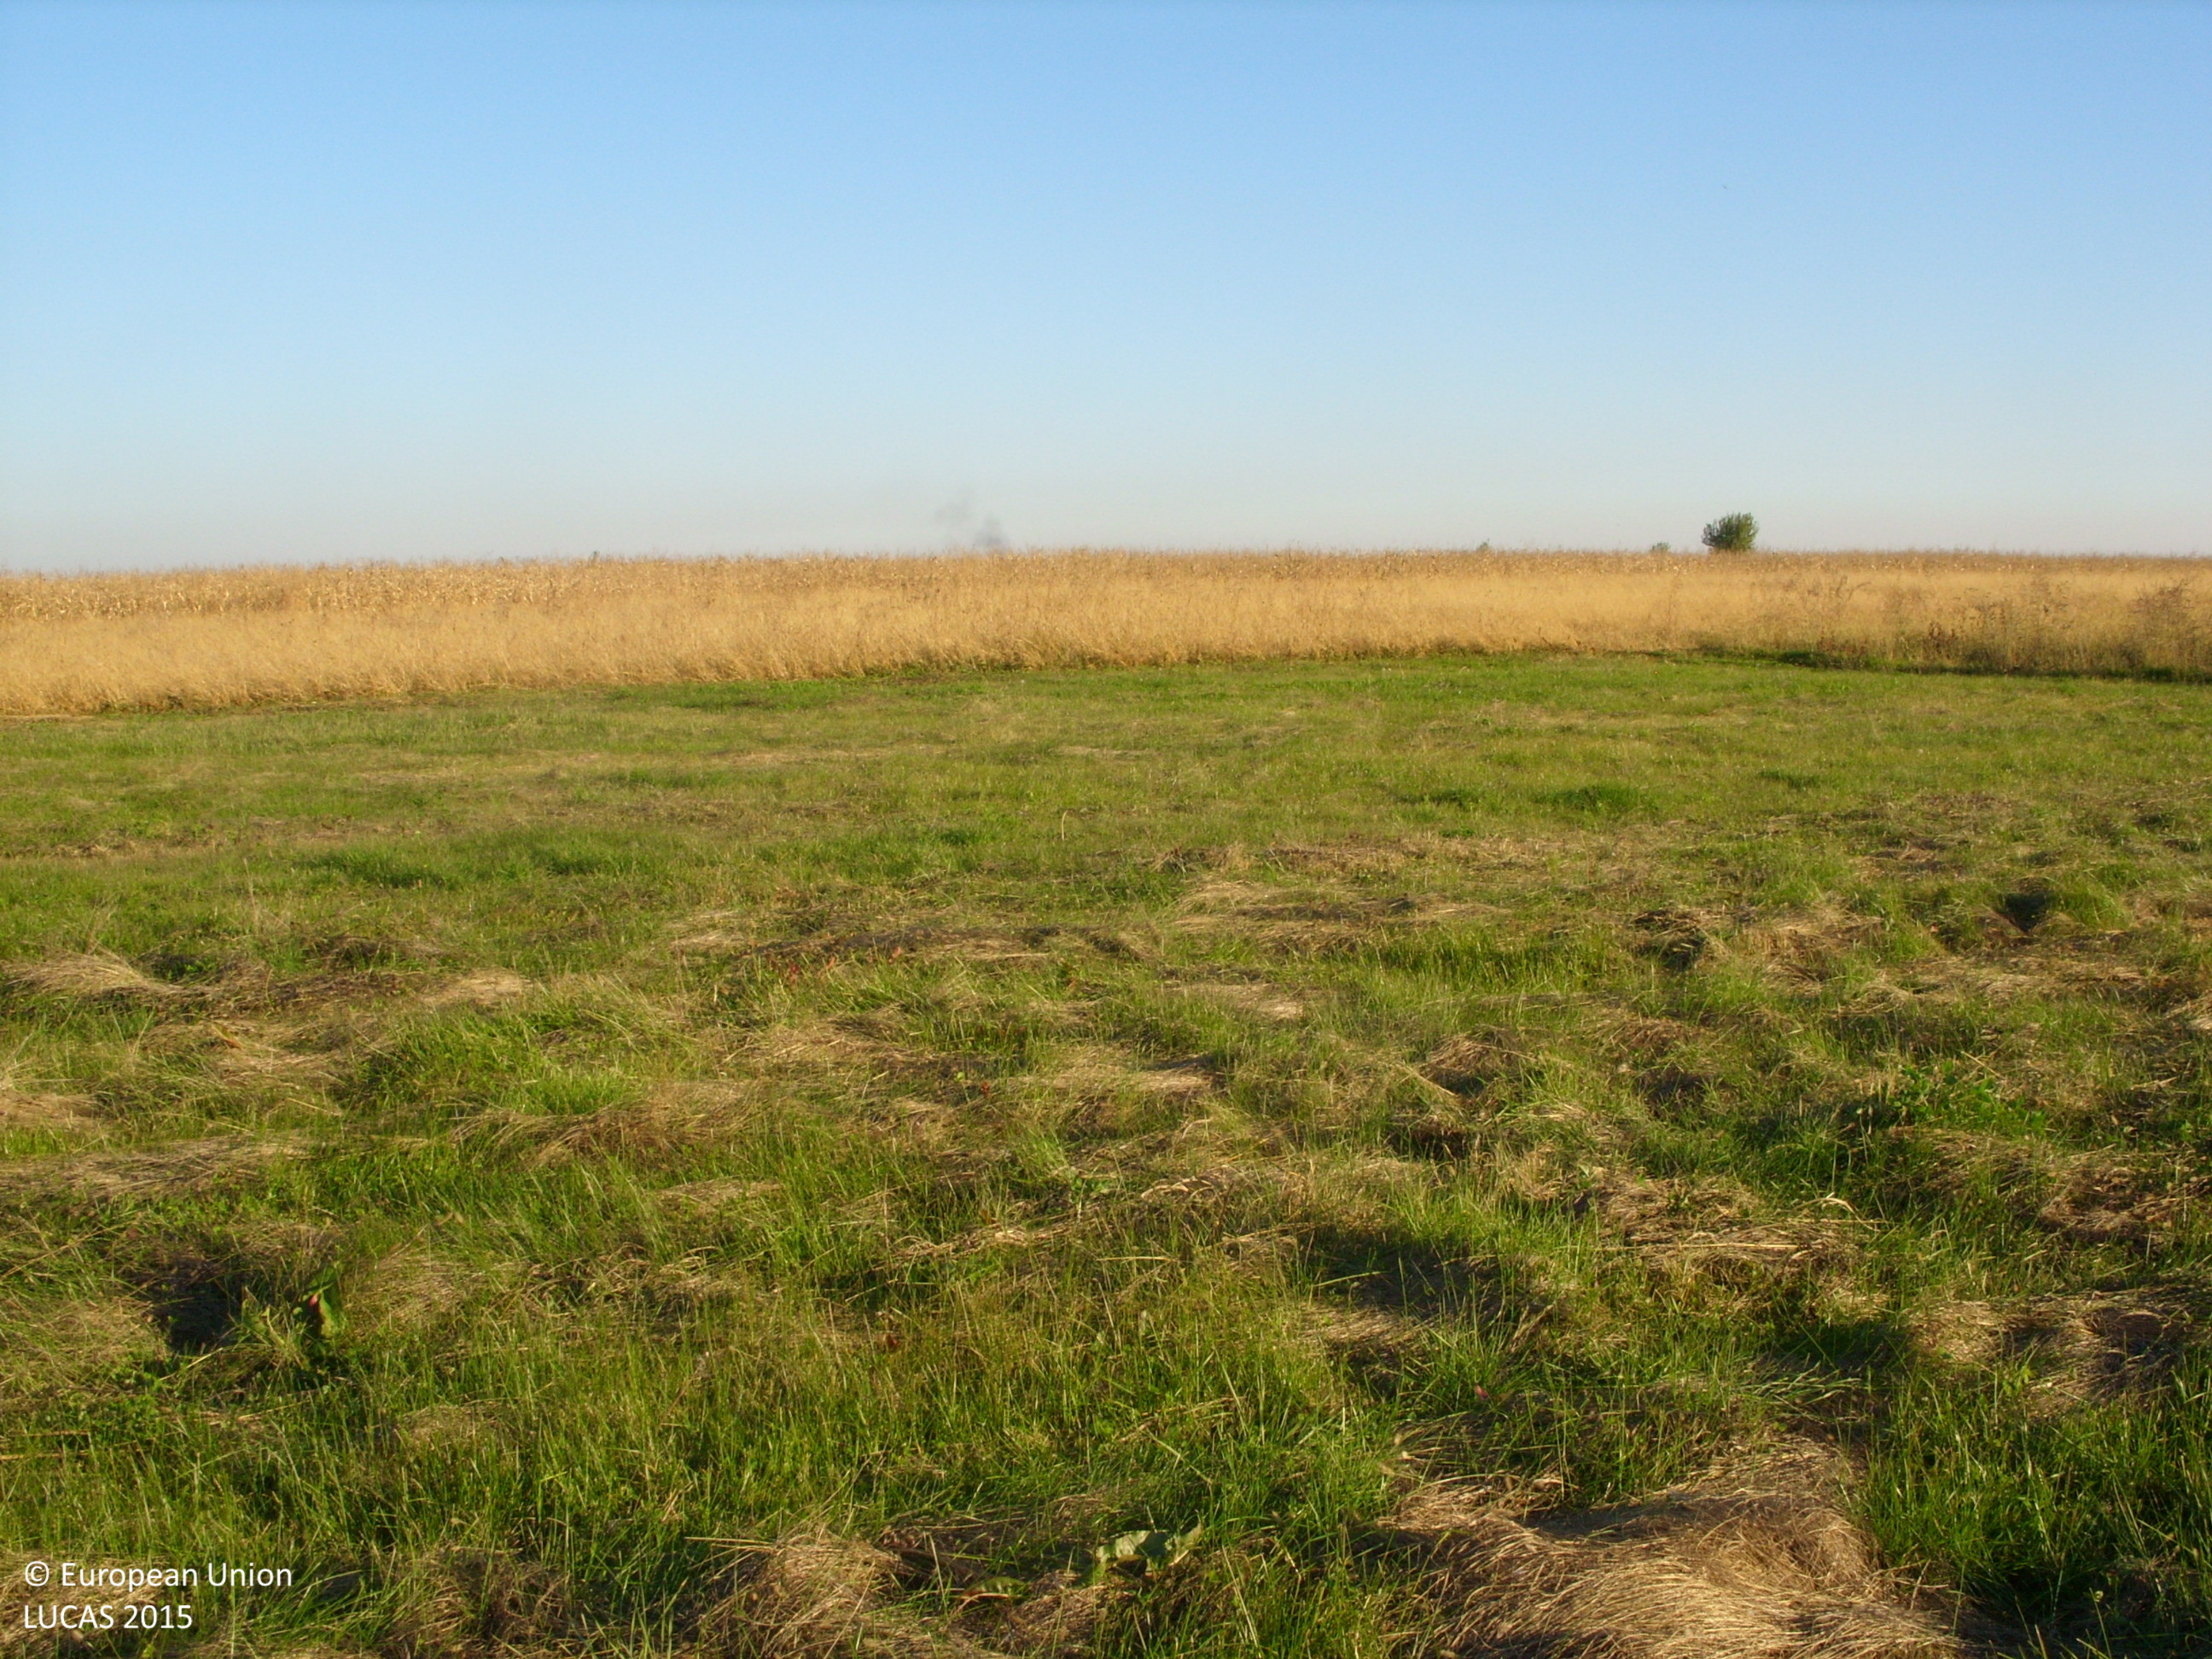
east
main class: Grassland
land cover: Grassland without tree/shrub cover
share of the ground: > 75 %
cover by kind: herbaceous plants 100 %
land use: Agriculture (excluding fallow land and kitchen gardens)
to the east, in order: Grassland without tree/shrub cover; Ditches and canals; Maize
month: November
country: BG
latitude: 42.4110
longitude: 24.8692
